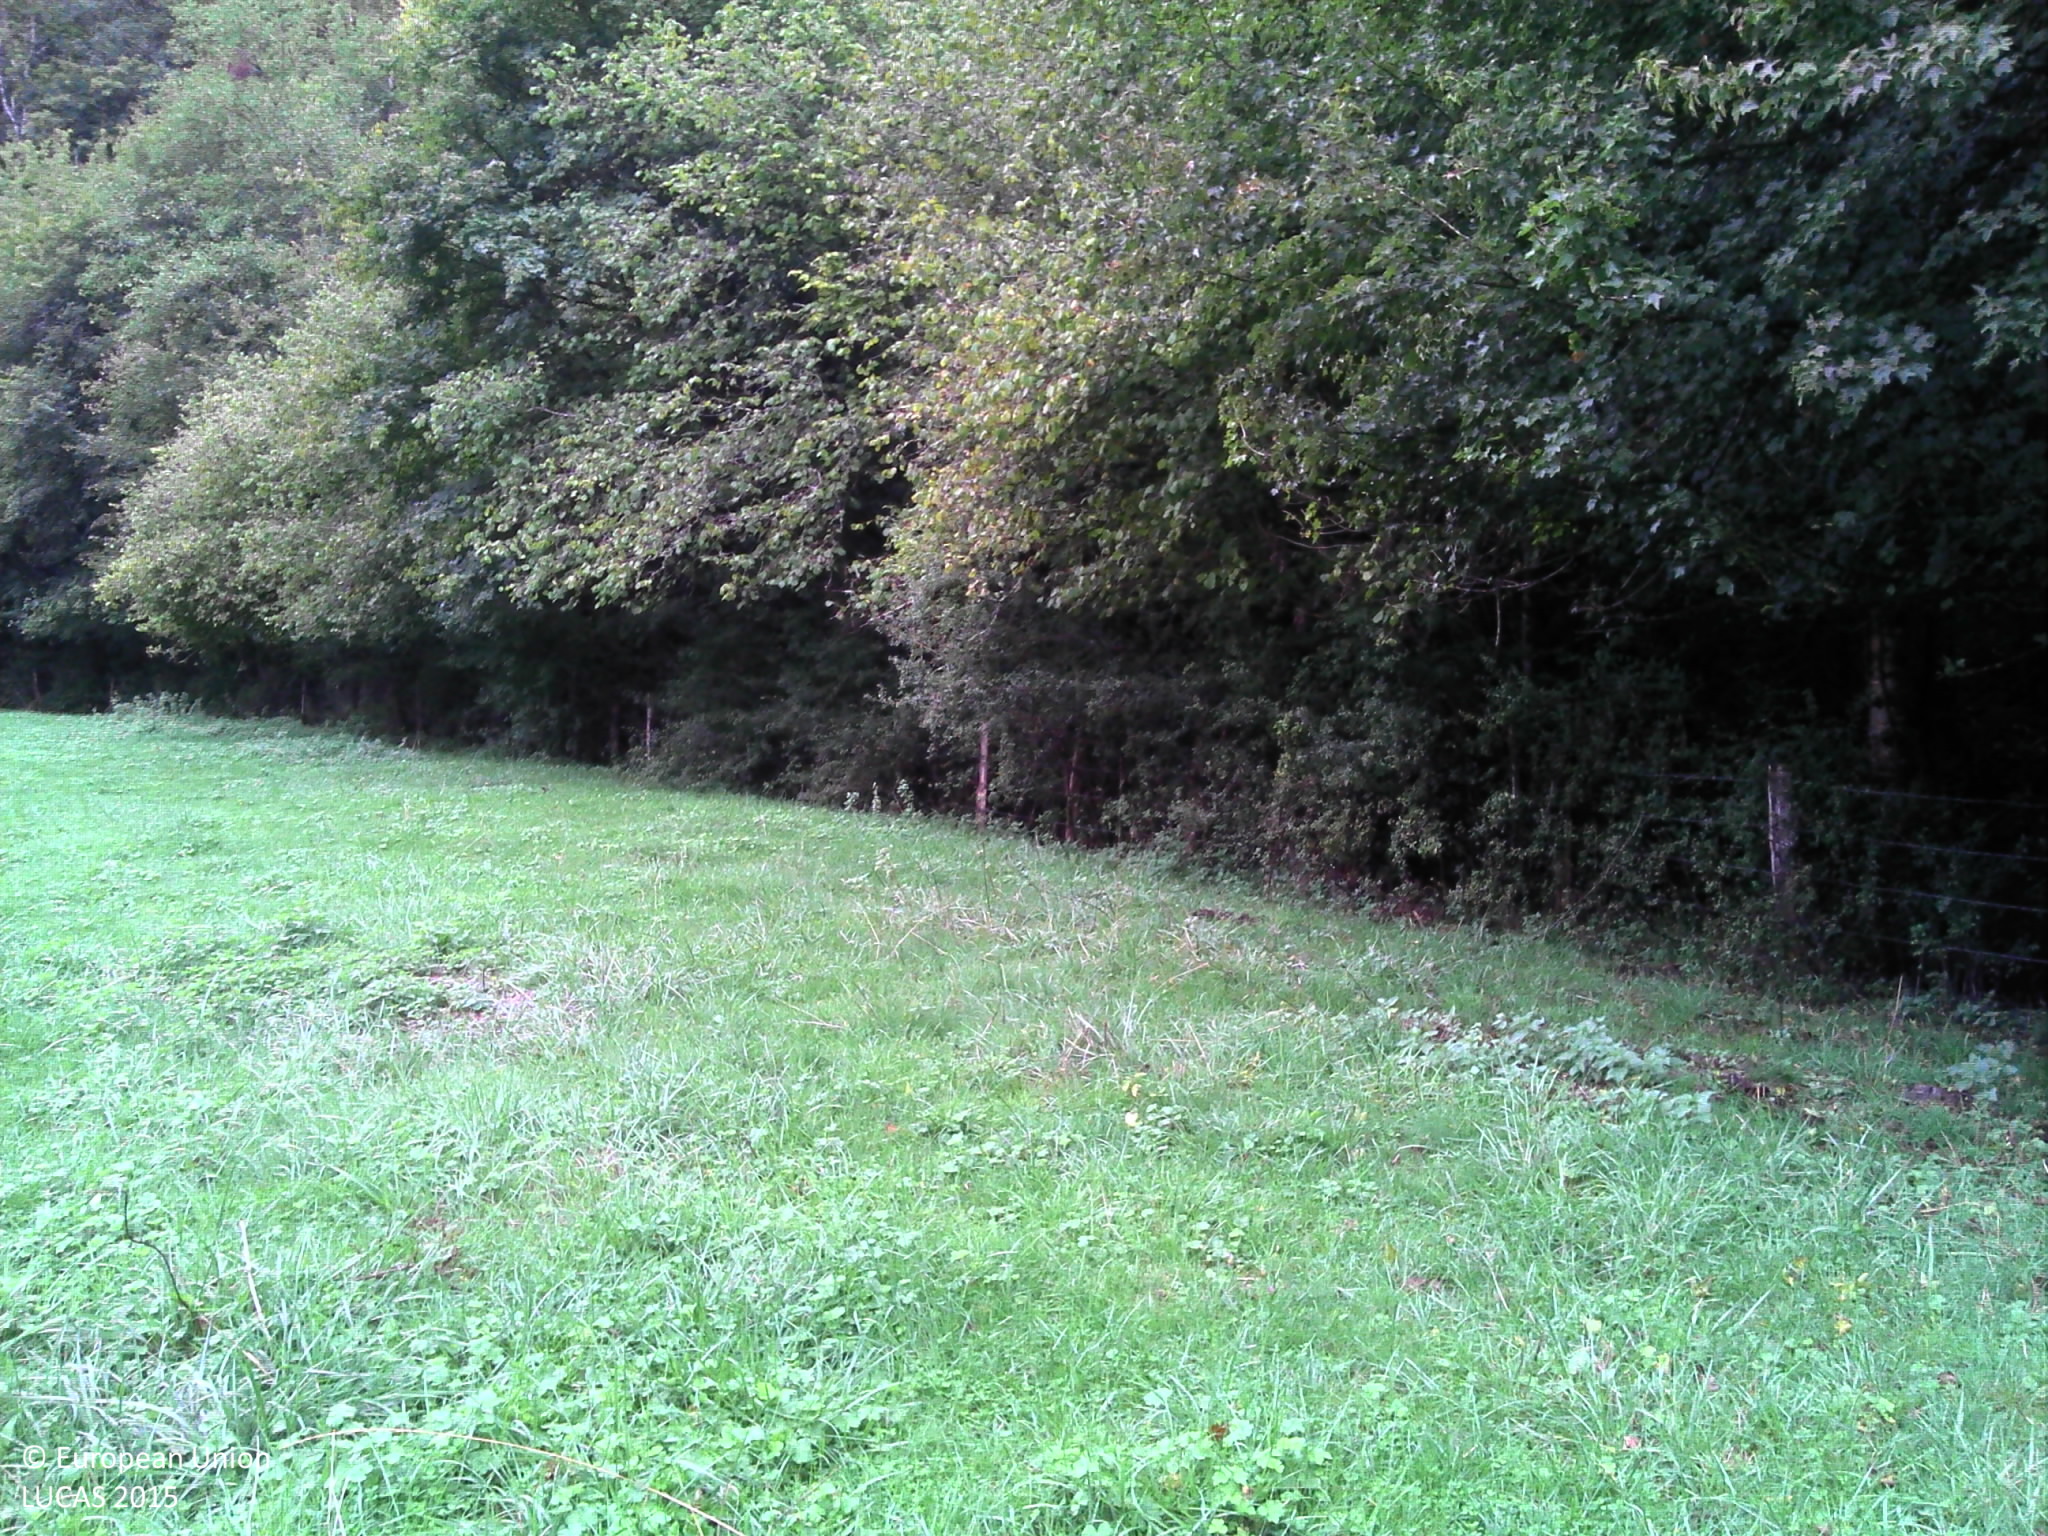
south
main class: Grassland
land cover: Grassland without tree/shrub cover
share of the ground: > 75 %
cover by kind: herbaceous plants 100 %
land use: Agriculture (excluding fallow land and kitchen gardens)
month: September
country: FR
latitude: 47.6493
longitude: 4.4205
